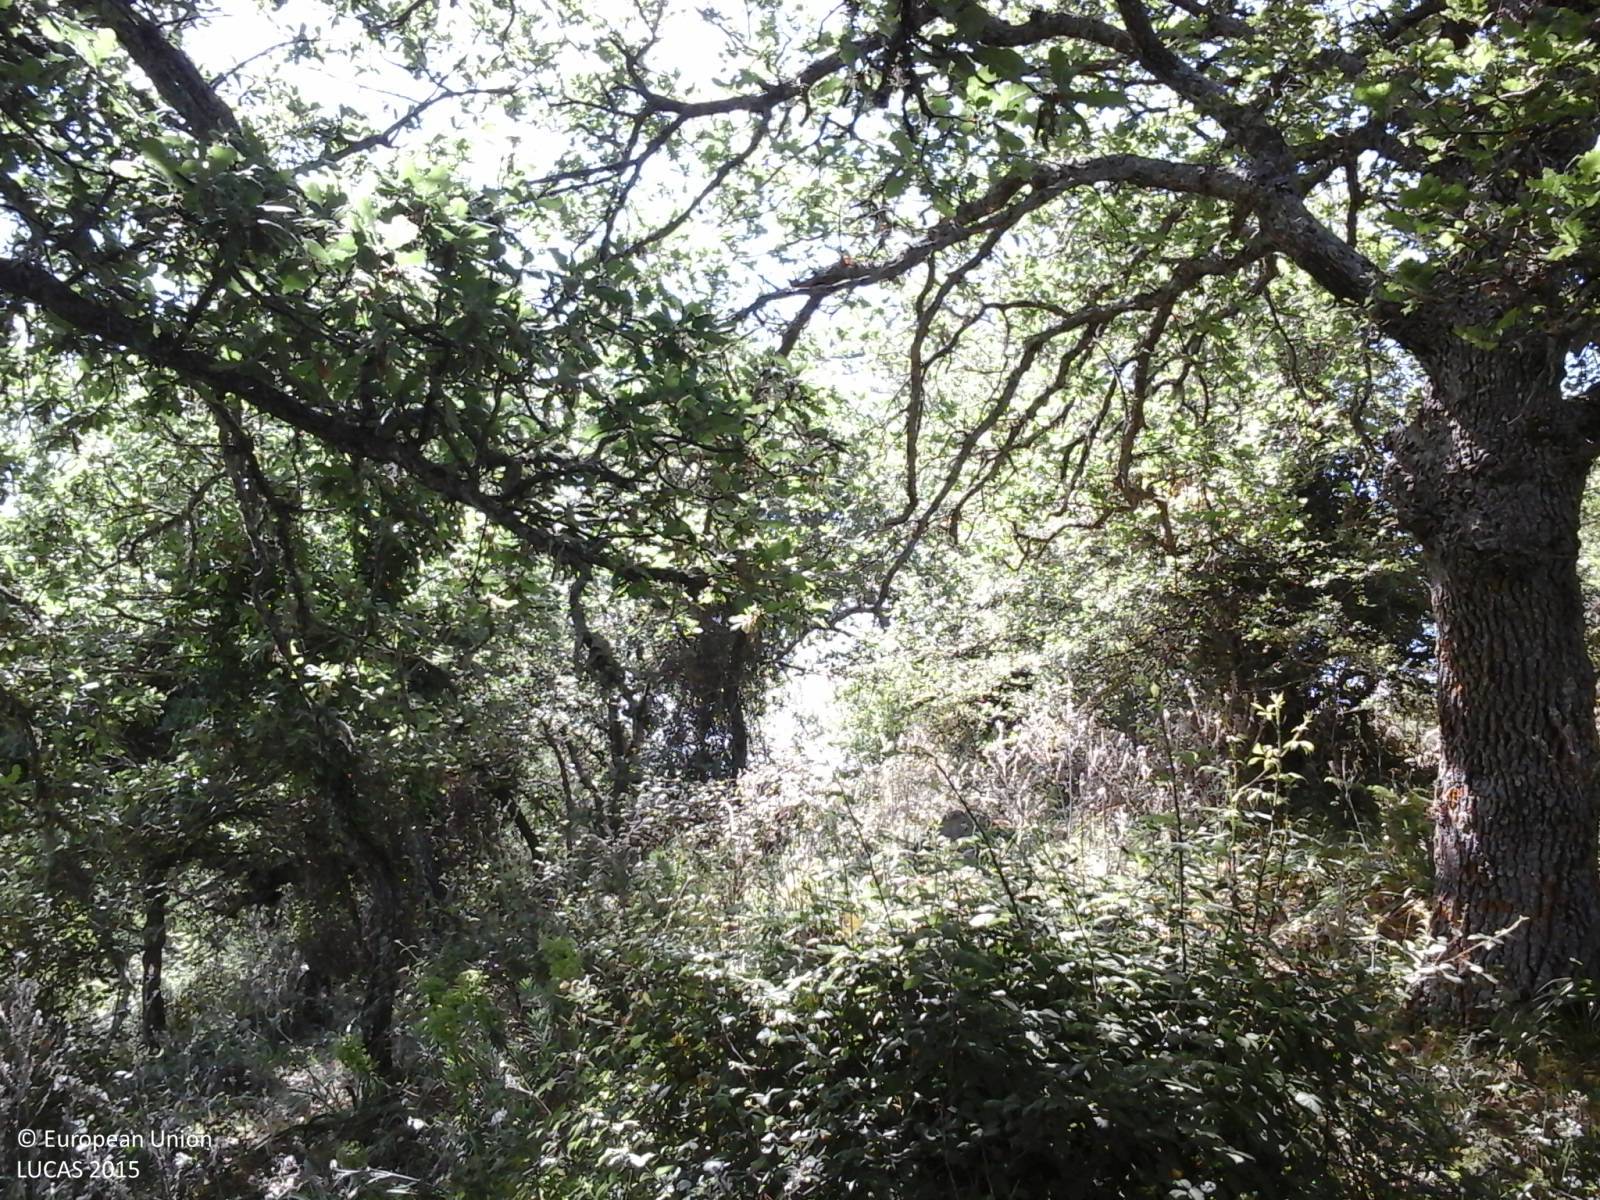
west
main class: Woodland
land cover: Broadleaved woodland
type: thermophilous deciduous forest
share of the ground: 50 - 75 %
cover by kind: broadleaved forest trees 75 %, unconsolidated bare surface 15 %, shrubs 5 %, consolidated bare surface 5 %
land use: Forestry
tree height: > 5 m
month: May
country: IT
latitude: 40.2823
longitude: 9.2161
